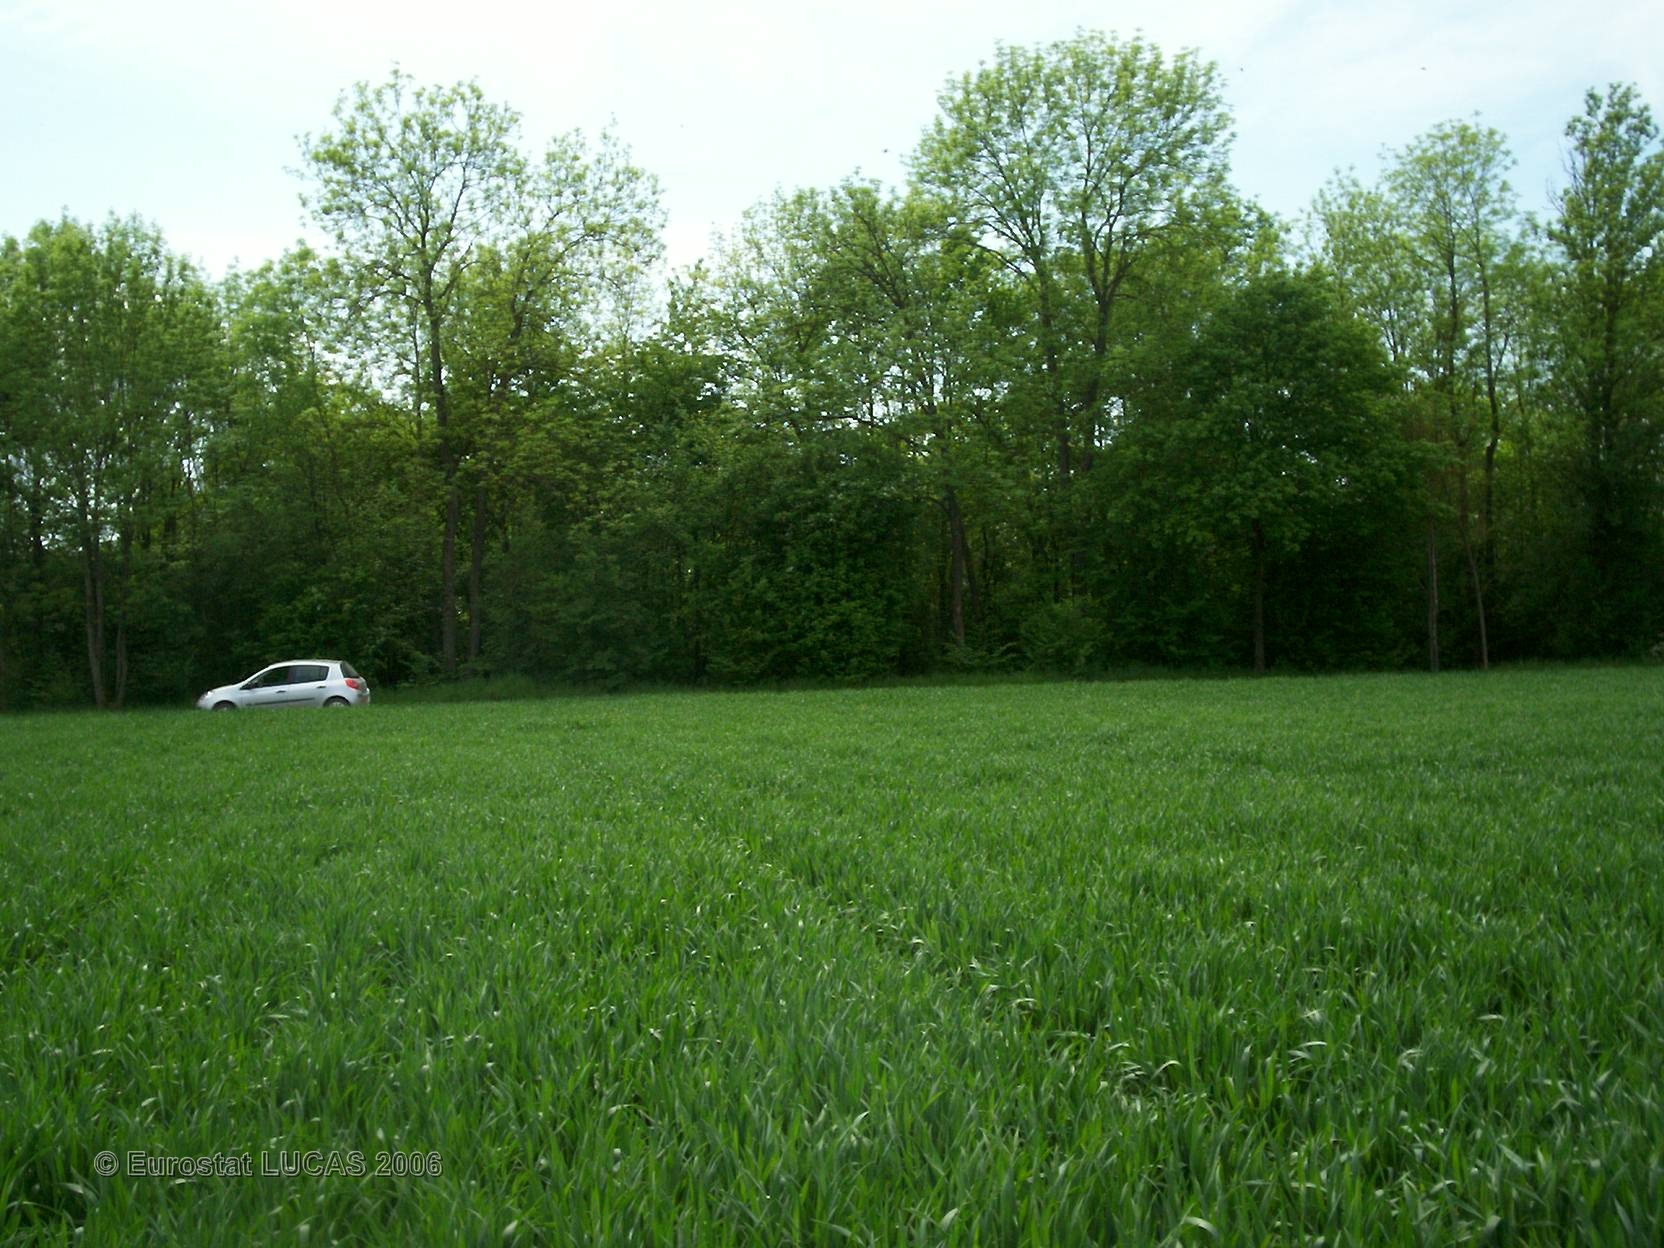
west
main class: Cropland
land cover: Common wheat
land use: Agriculture (excluding fallow land and kitchen gardens)
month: May
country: FR
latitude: 48.9282
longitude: 4.3866
